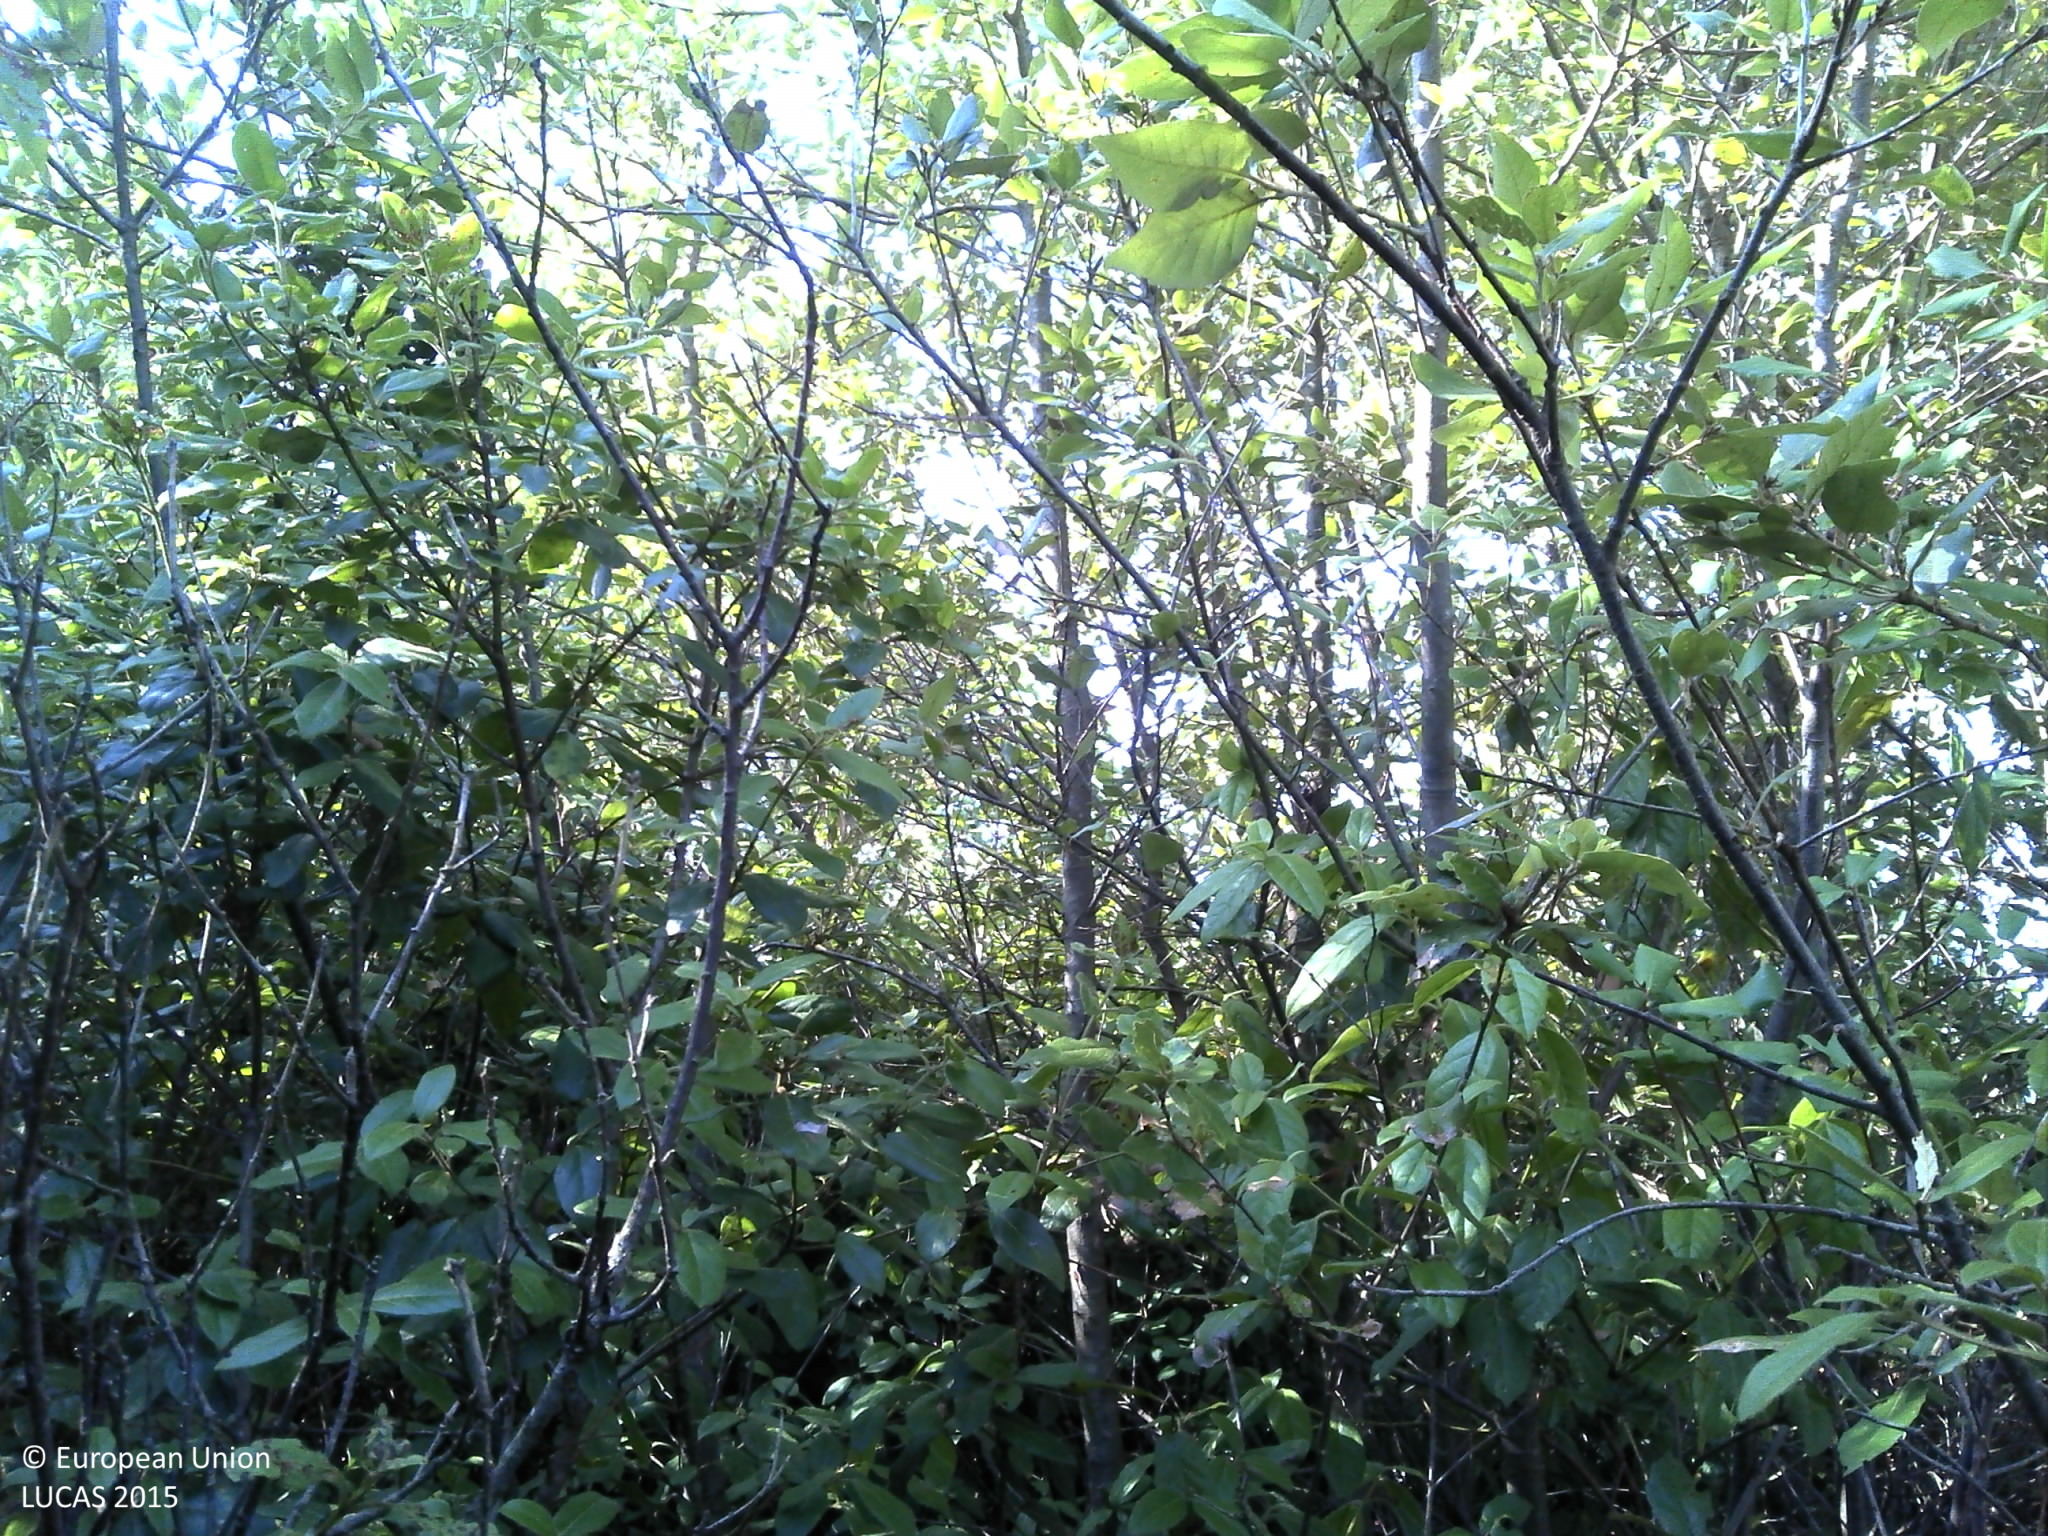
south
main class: Woodland
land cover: Other mixed woodland
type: coniferous forest of the mediterranean region
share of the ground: 25 - 50 %
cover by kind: shrubs 40 %, coniferous forest trees 30 %, broadleaved forest trees 20 %, unconsolidated bare surface 10 %
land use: Semi-natural and natural areas not in use
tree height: > 5 m
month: August
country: HR
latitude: 42.9296
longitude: 17.1081
